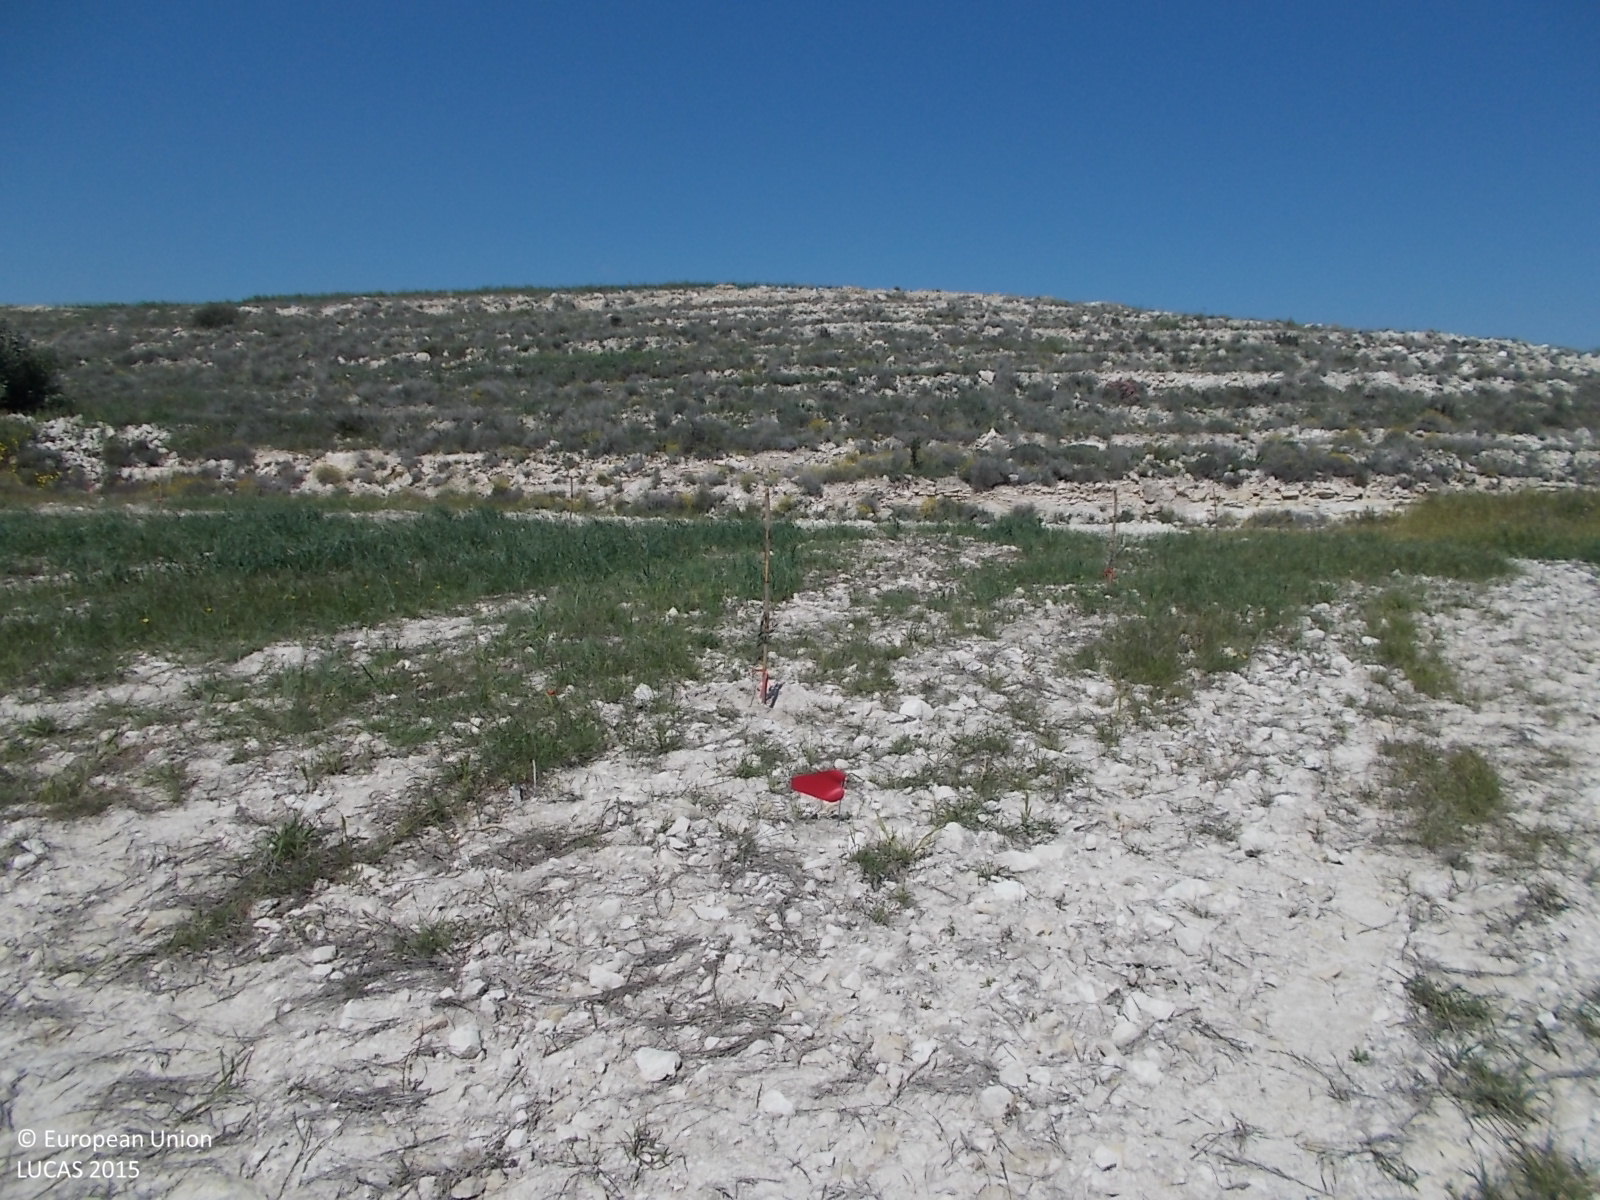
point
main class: Cropland
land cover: Olive groves
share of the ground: < 10 %
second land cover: Grassland without tree/shrub cover
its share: 25 - 50 %
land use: Agriculture (excluding fallow land and kitchen gardens)
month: April
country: CY
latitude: 35.0089
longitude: 33.5476
